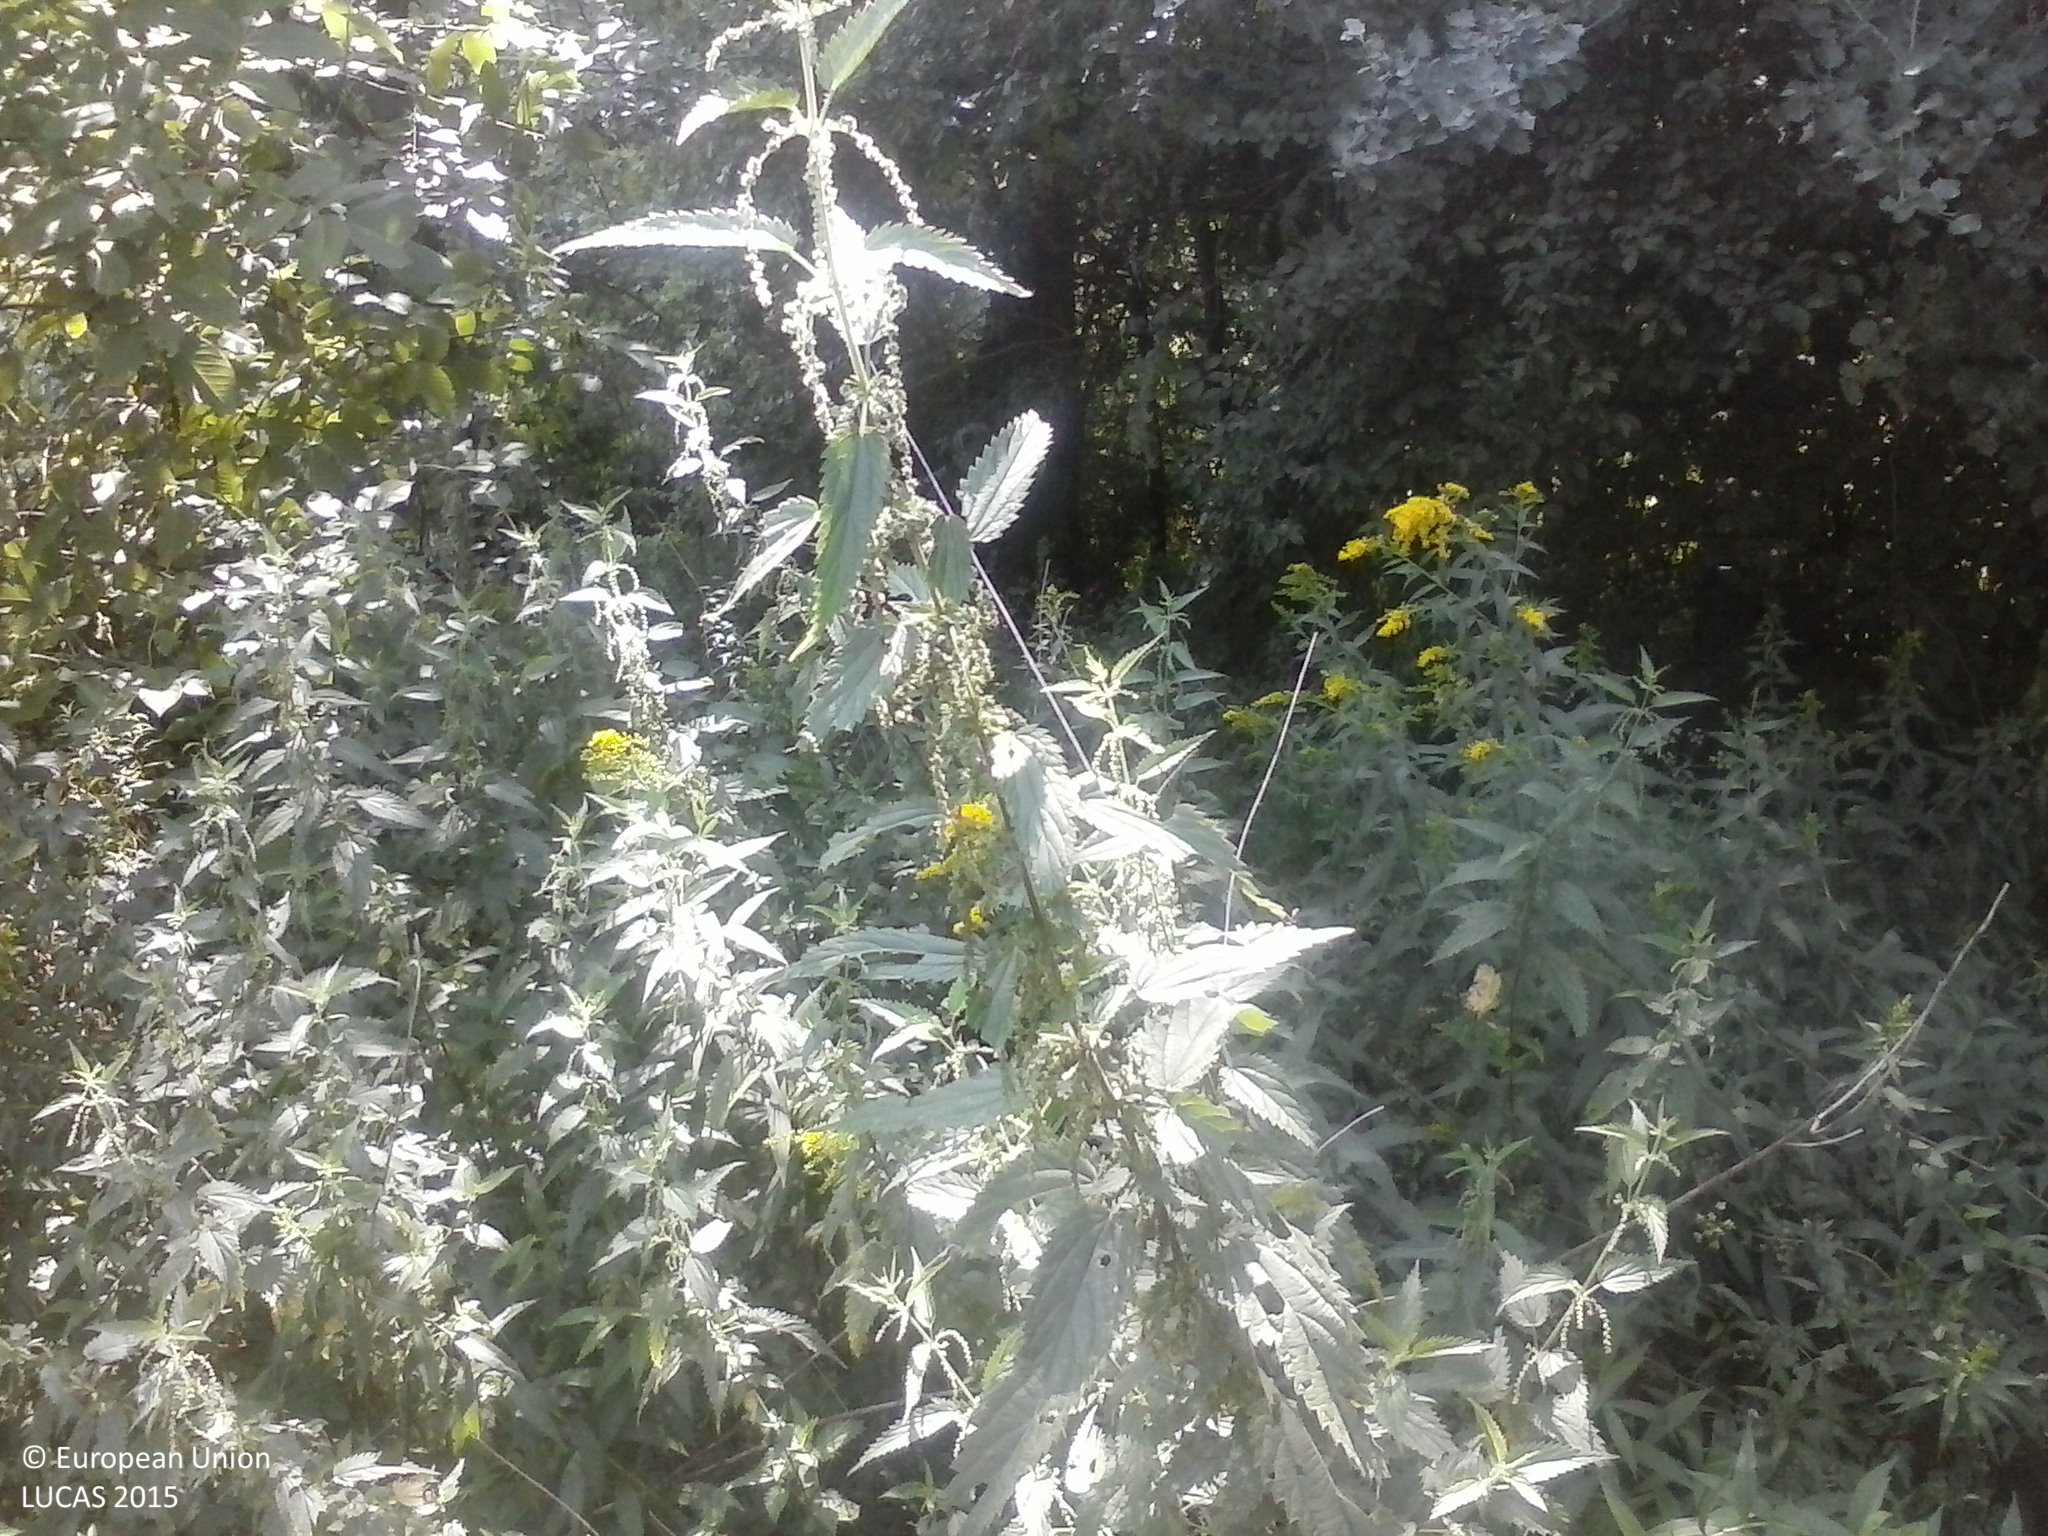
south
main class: Cropland
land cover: Maize
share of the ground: > 75 %
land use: Agriculture (excluding fallow land and kitchen gardens)
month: August
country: HU
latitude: 45.8993
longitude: 17.8540
